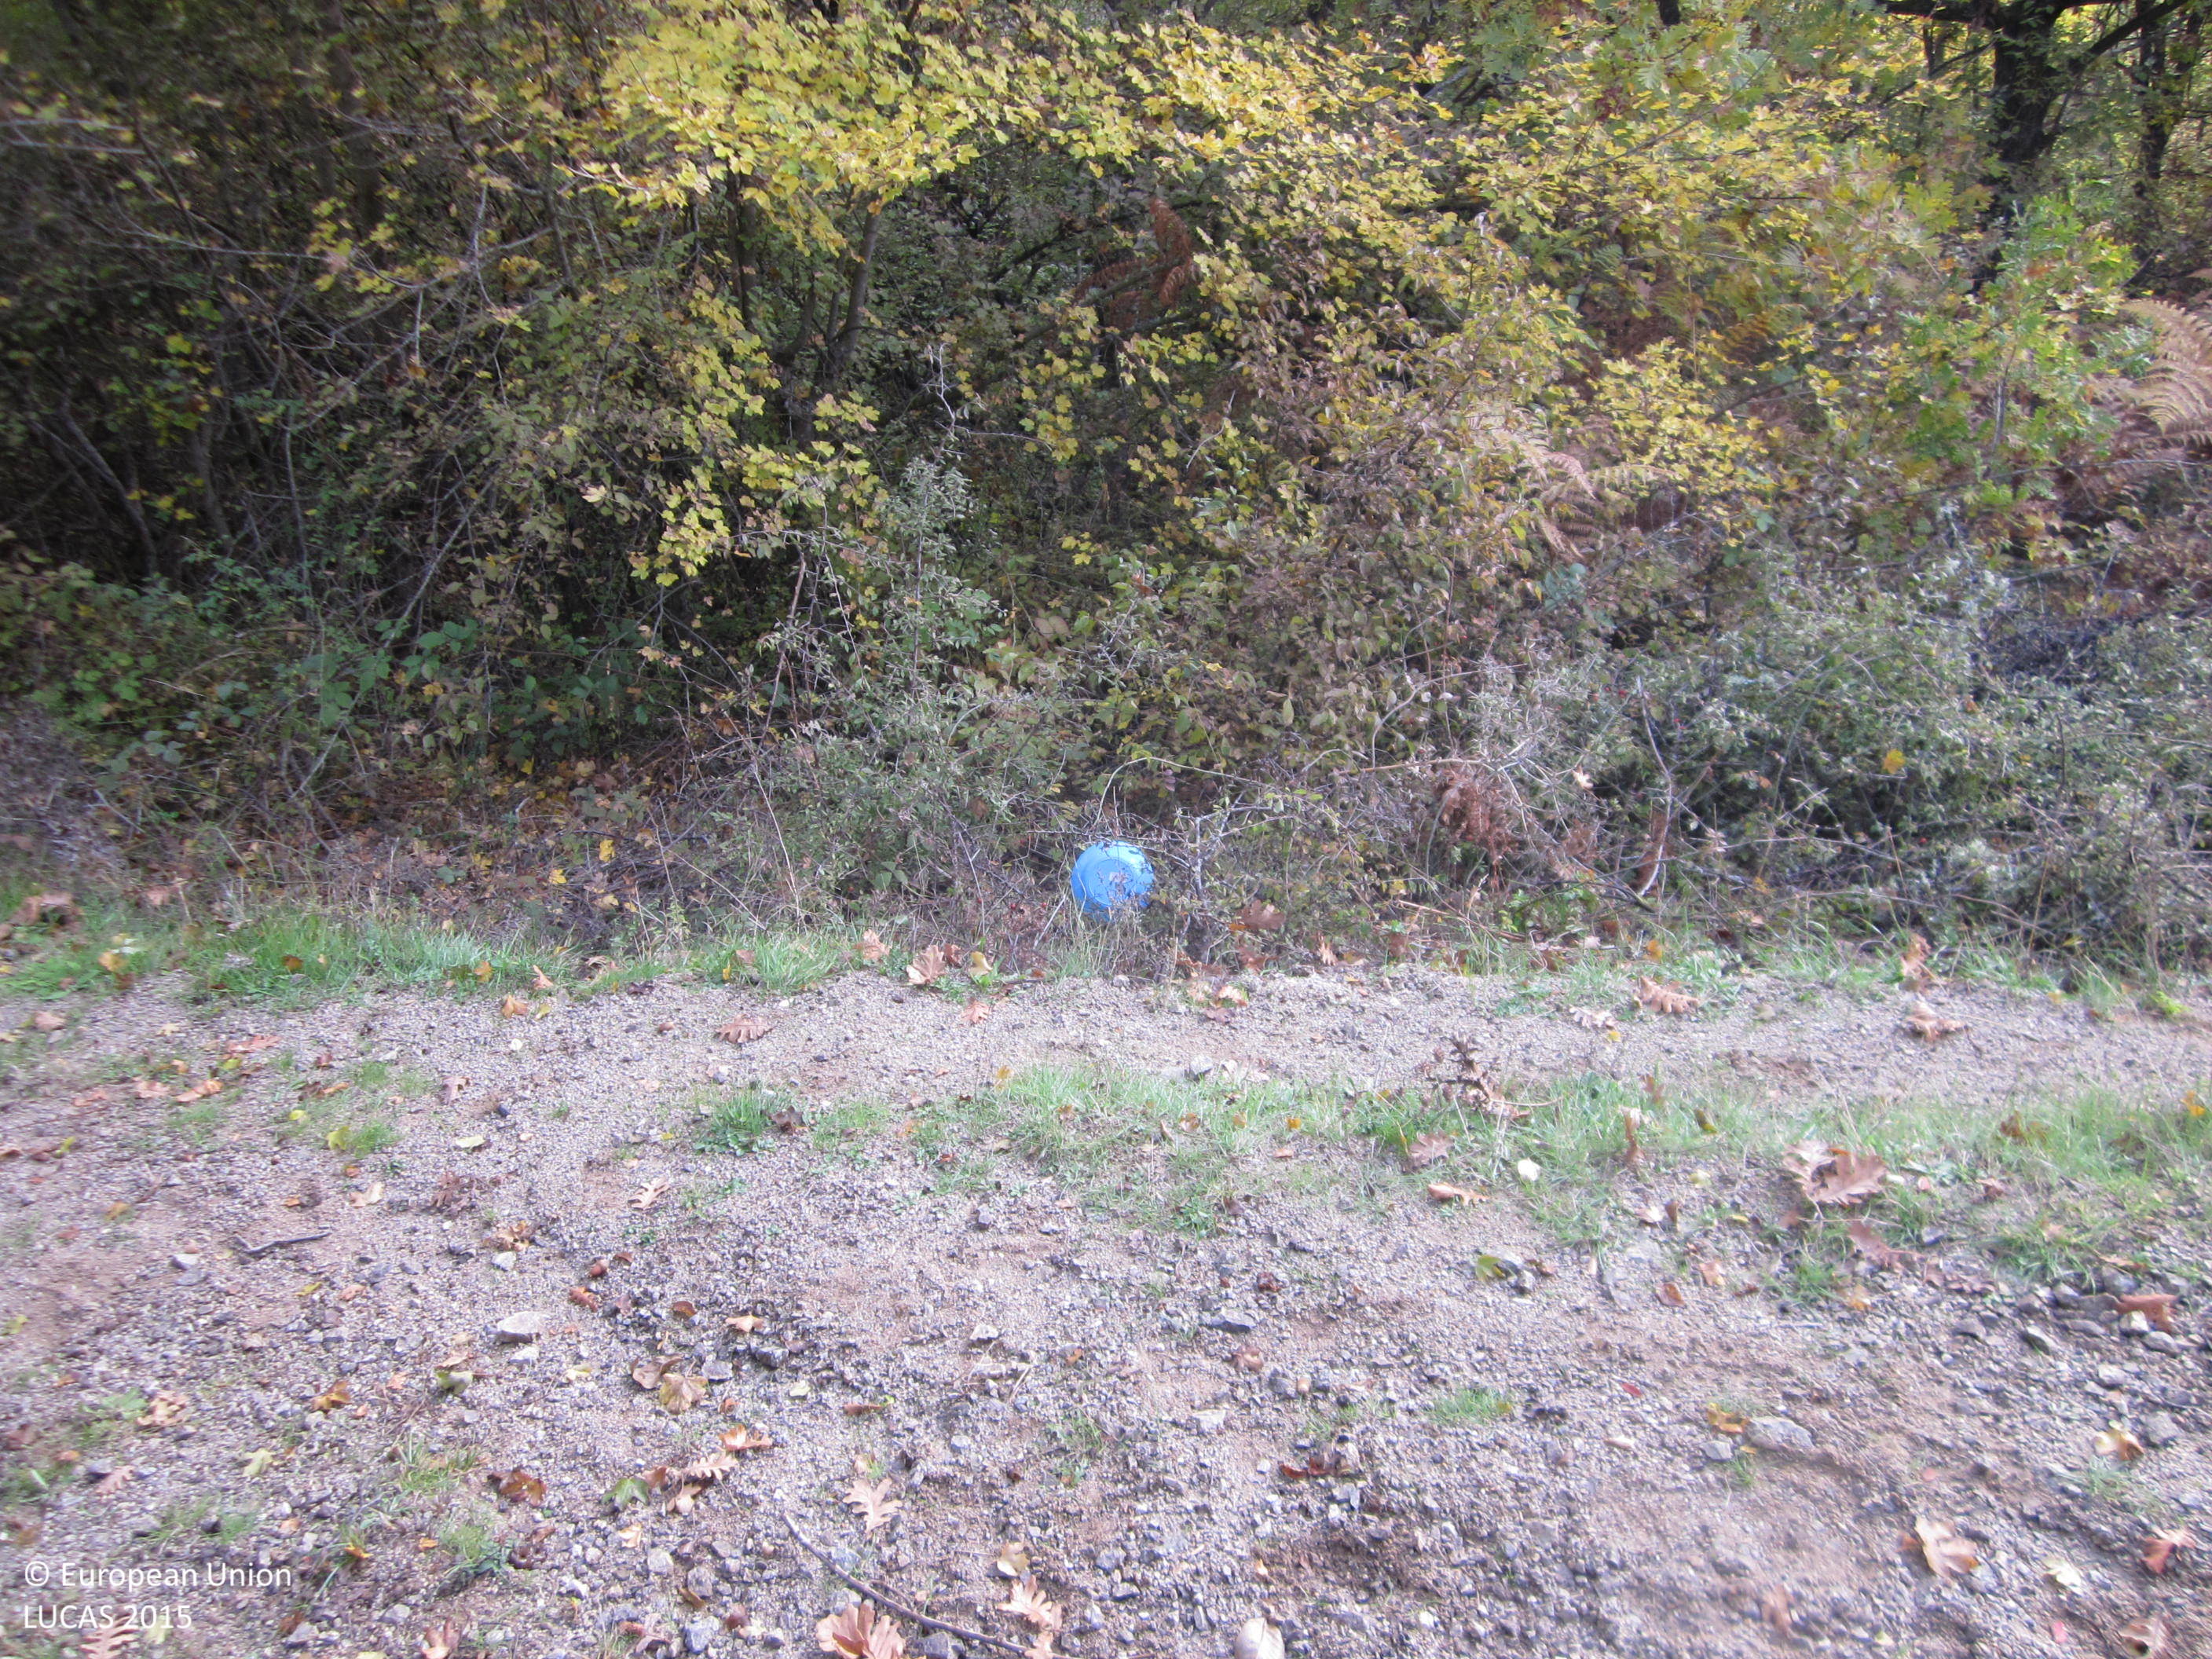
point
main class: Woodland
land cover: Broadleaved woodland
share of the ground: 50 - 75 %
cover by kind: broadleaved forest trees 70 %, shrubs 15 %, herbaceous plants 15 %
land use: Forestry
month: November
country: BG
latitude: 41.3504
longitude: 25.6804
